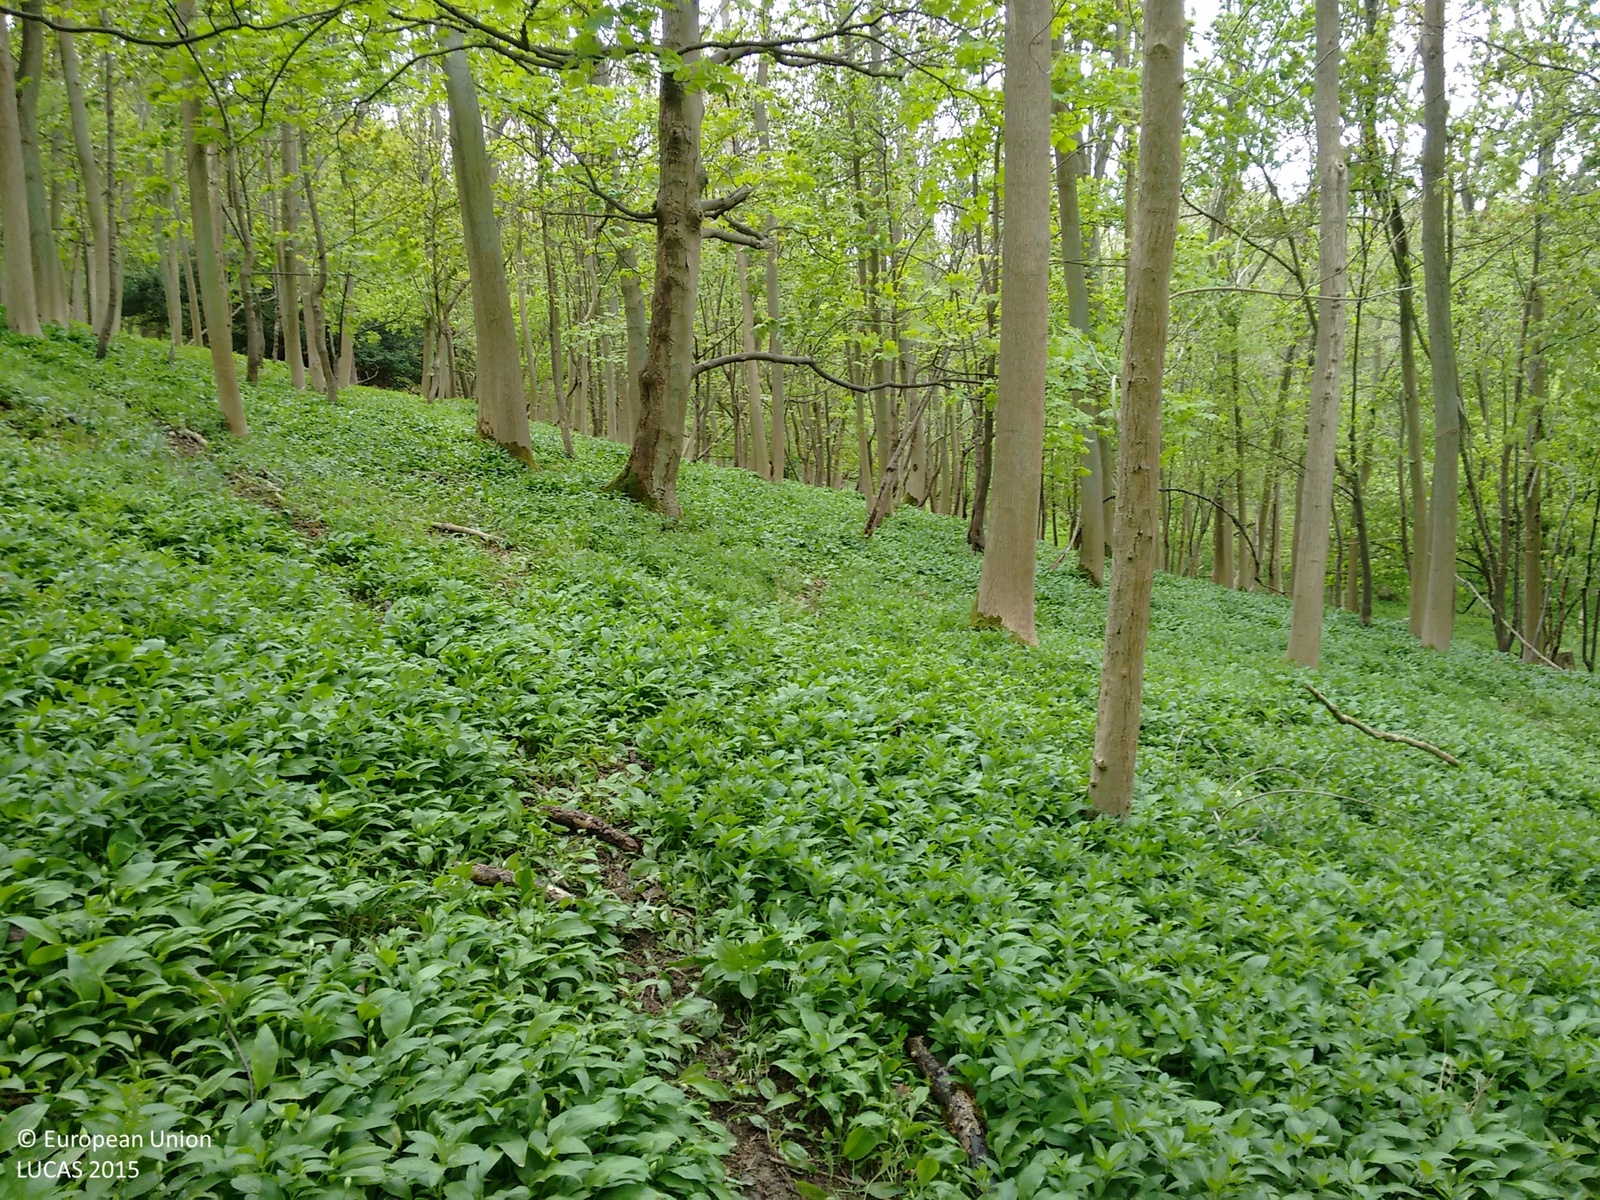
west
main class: Woodland
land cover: Broadleaved woodland
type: mesophytic deciduous forest
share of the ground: > 75 %
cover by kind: broadleaved forest trees 80 %, herbaceous plants 20 %
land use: Forestry
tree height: > 5 m
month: May
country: GB
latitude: 51.8299
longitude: -0.5887
